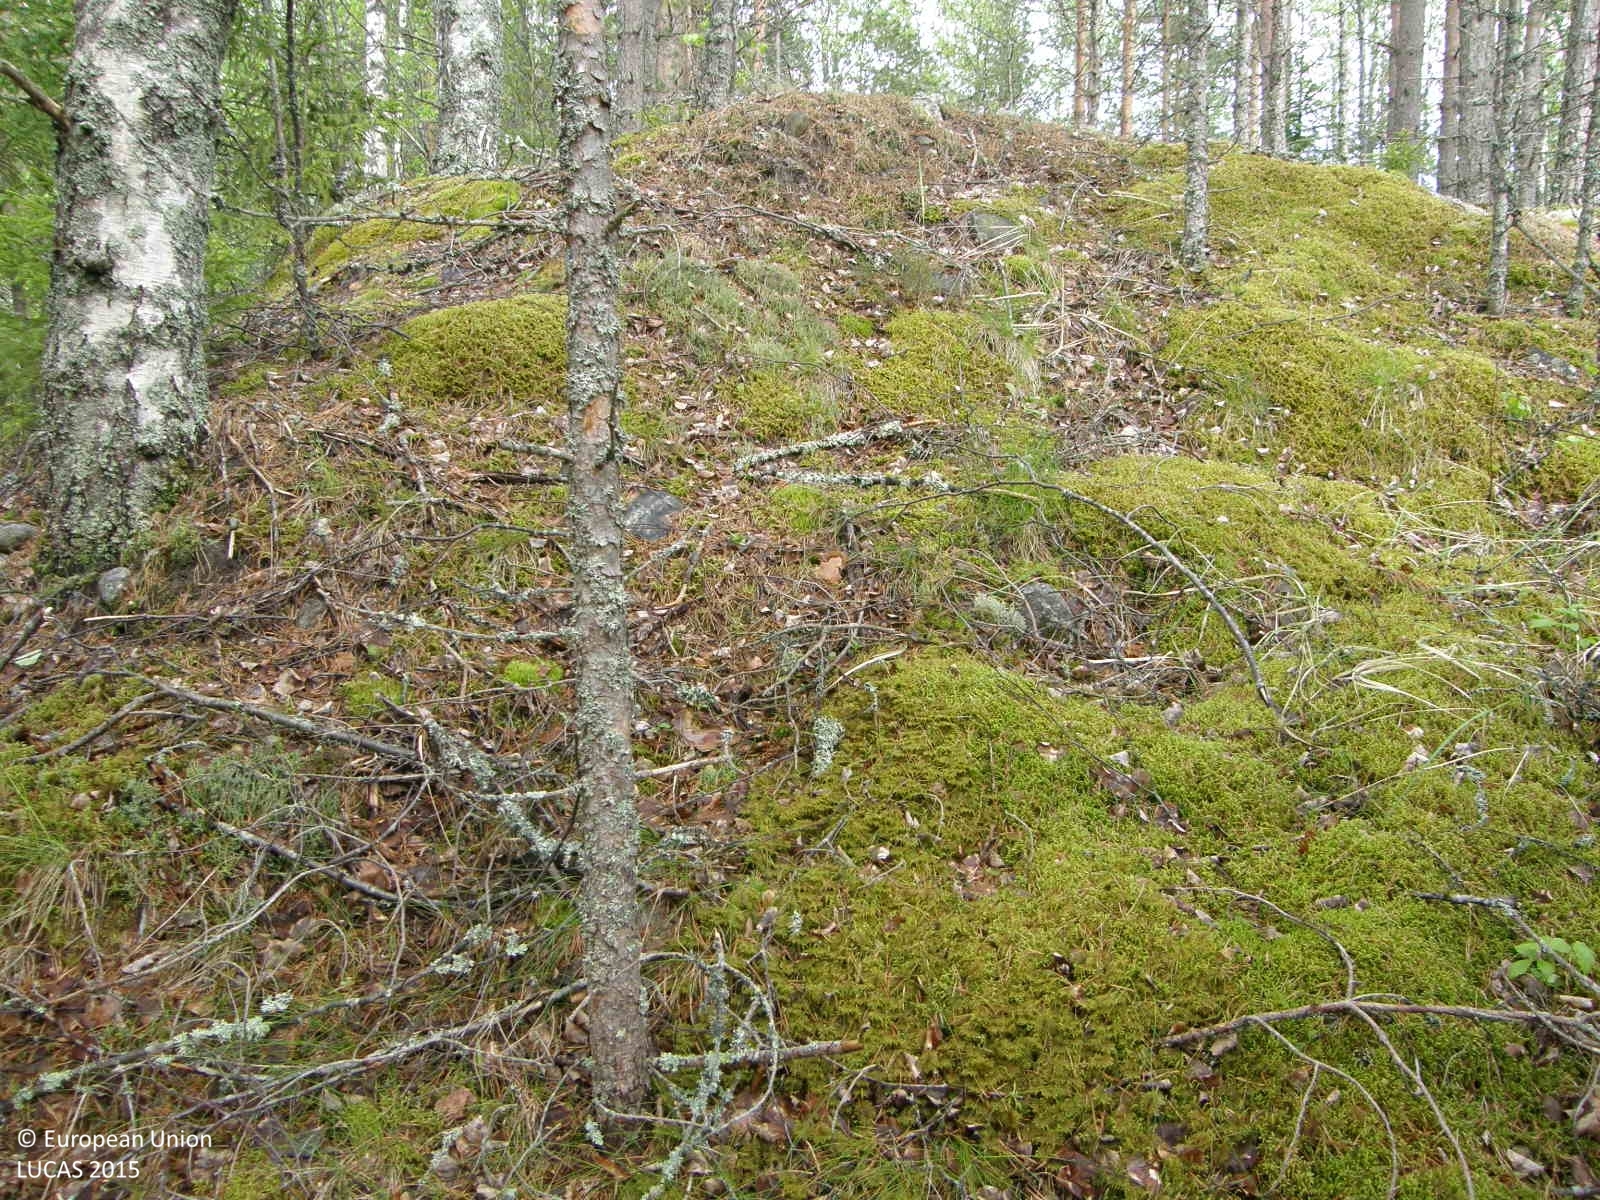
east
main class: Woodland
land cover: Pine dominated mixed woodland
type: boreal forest
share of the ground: > 75 %
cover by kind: coniferous forest trees 65 %, broadleaved forest trees 25 %, consolidated bare surface 5 %, unconsolidated bare surface 5 %
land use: Forestry
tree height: > 5 m
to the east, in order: Pine dominated mixed woodland; Electric lines; Ditches and canals; Paved roads, cycling and walking lanes; Ditches and canals; Spruce dominated mixed woodland; Electric lines; Other mixed woodland; Grassland without tree/shrub cover; Pine dominated mixed woodland; Spruce dominated mixed woodland; Other mixed woodland
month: June
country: FI
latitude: 61.9391
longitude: 21.6542
